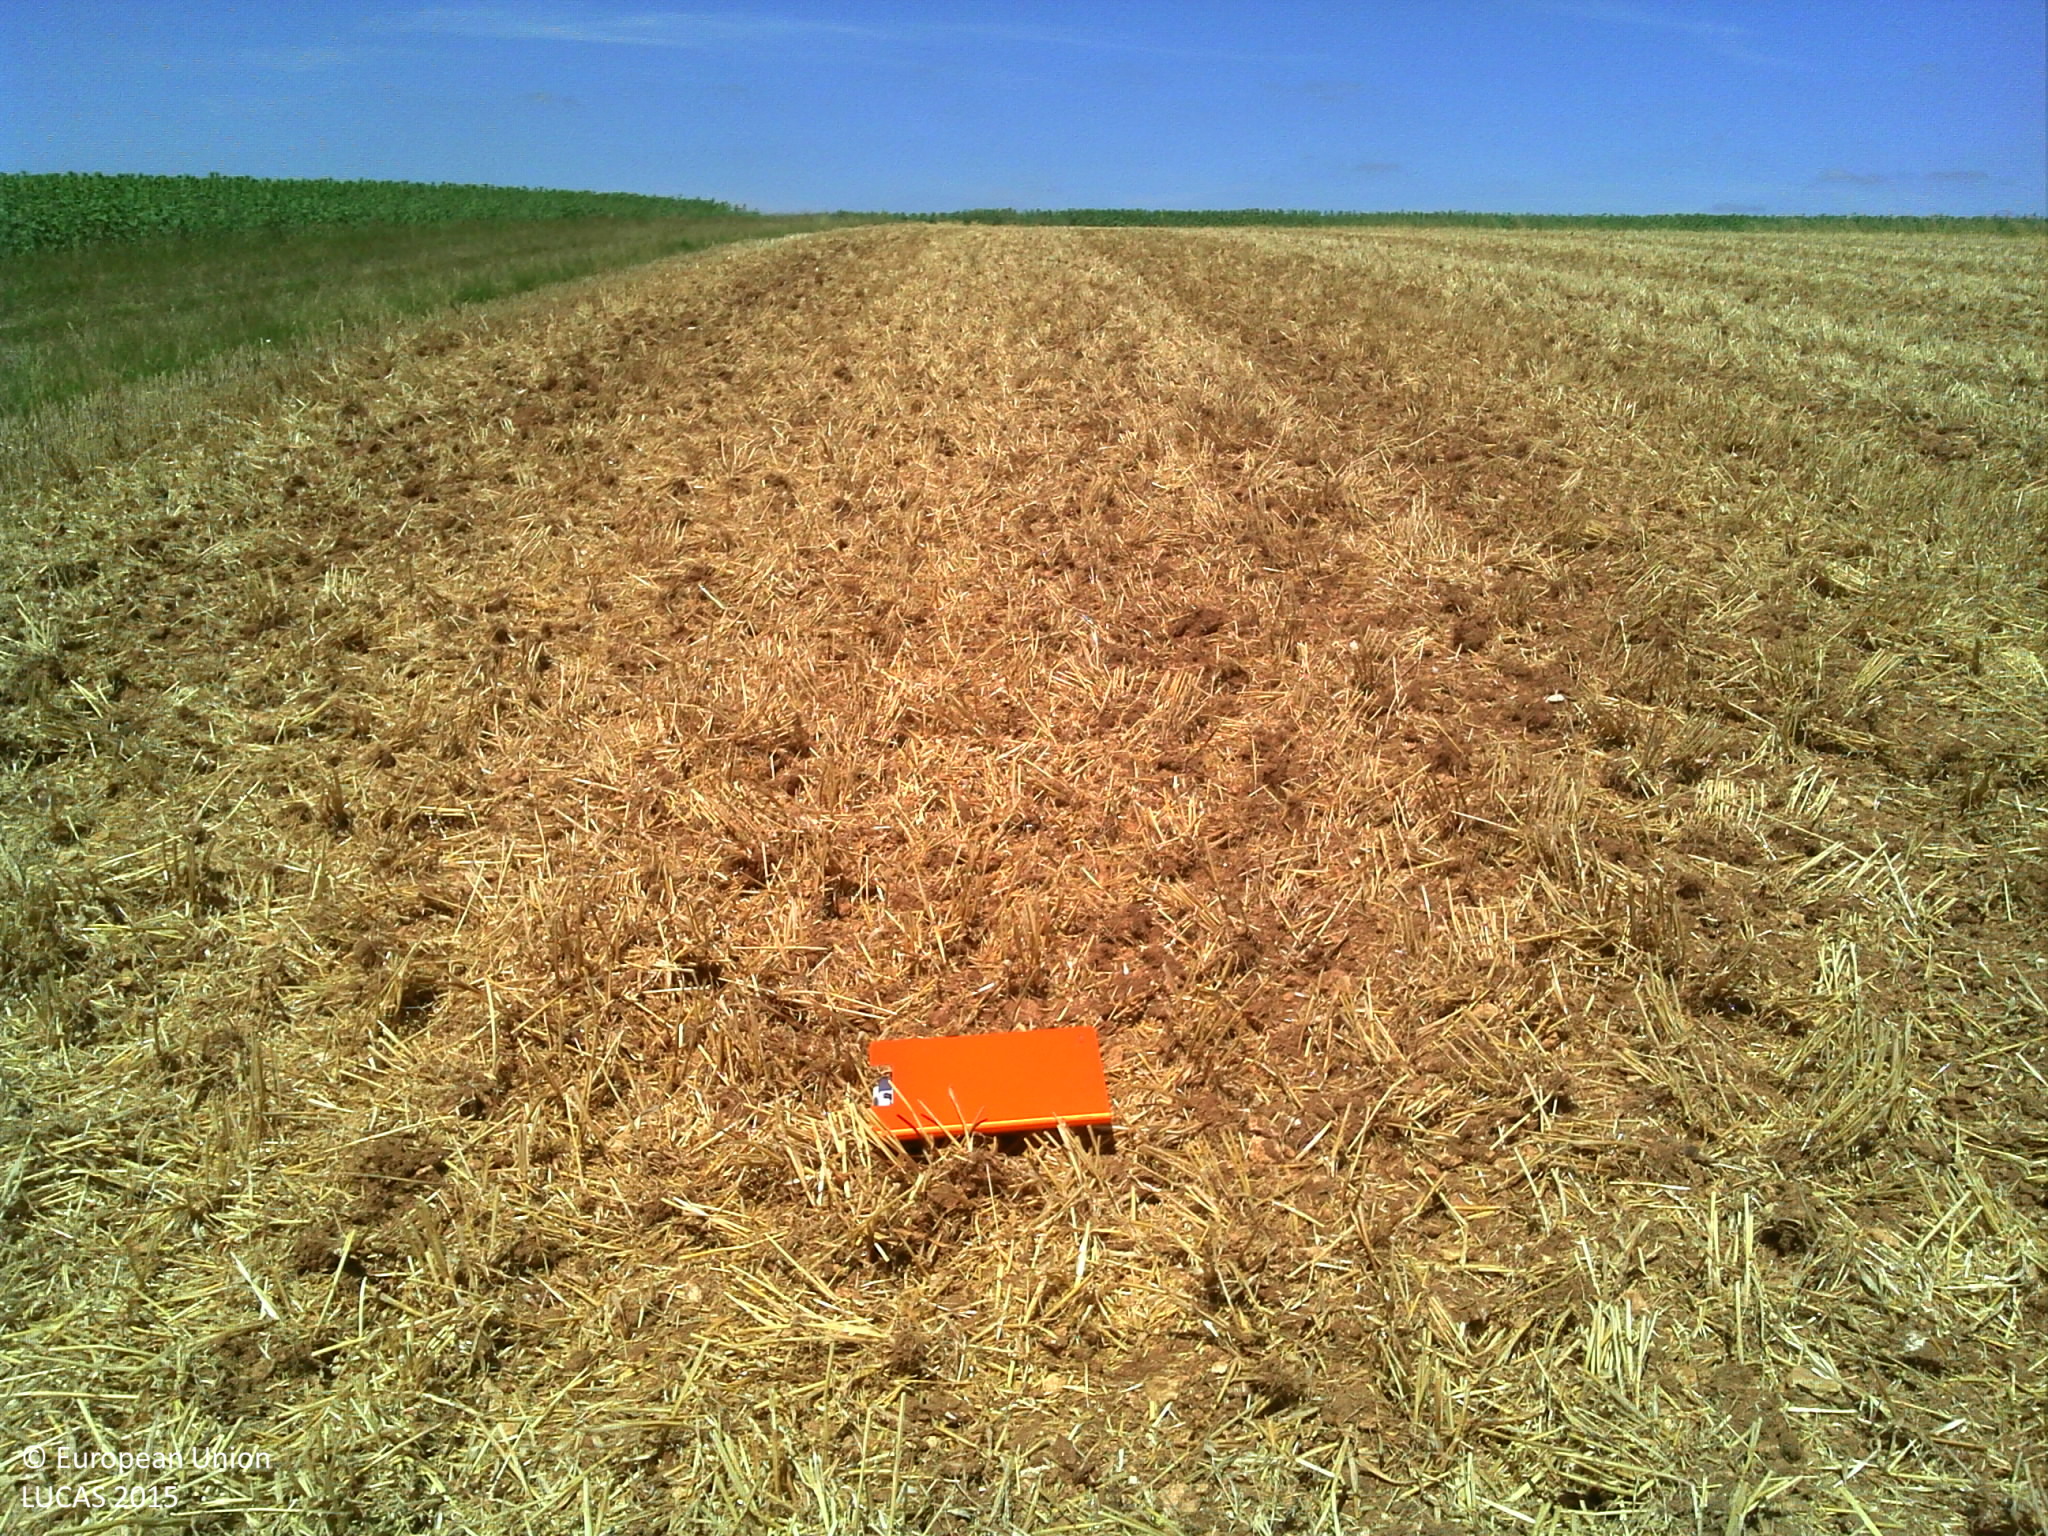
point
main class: Cropland
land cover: Barley
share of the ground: > 75 %
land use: Agriculture (excluding fallow land and kitchen gardens)
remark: Harvested field
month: June
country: FR
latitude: 47.1986
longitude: 2.6146
